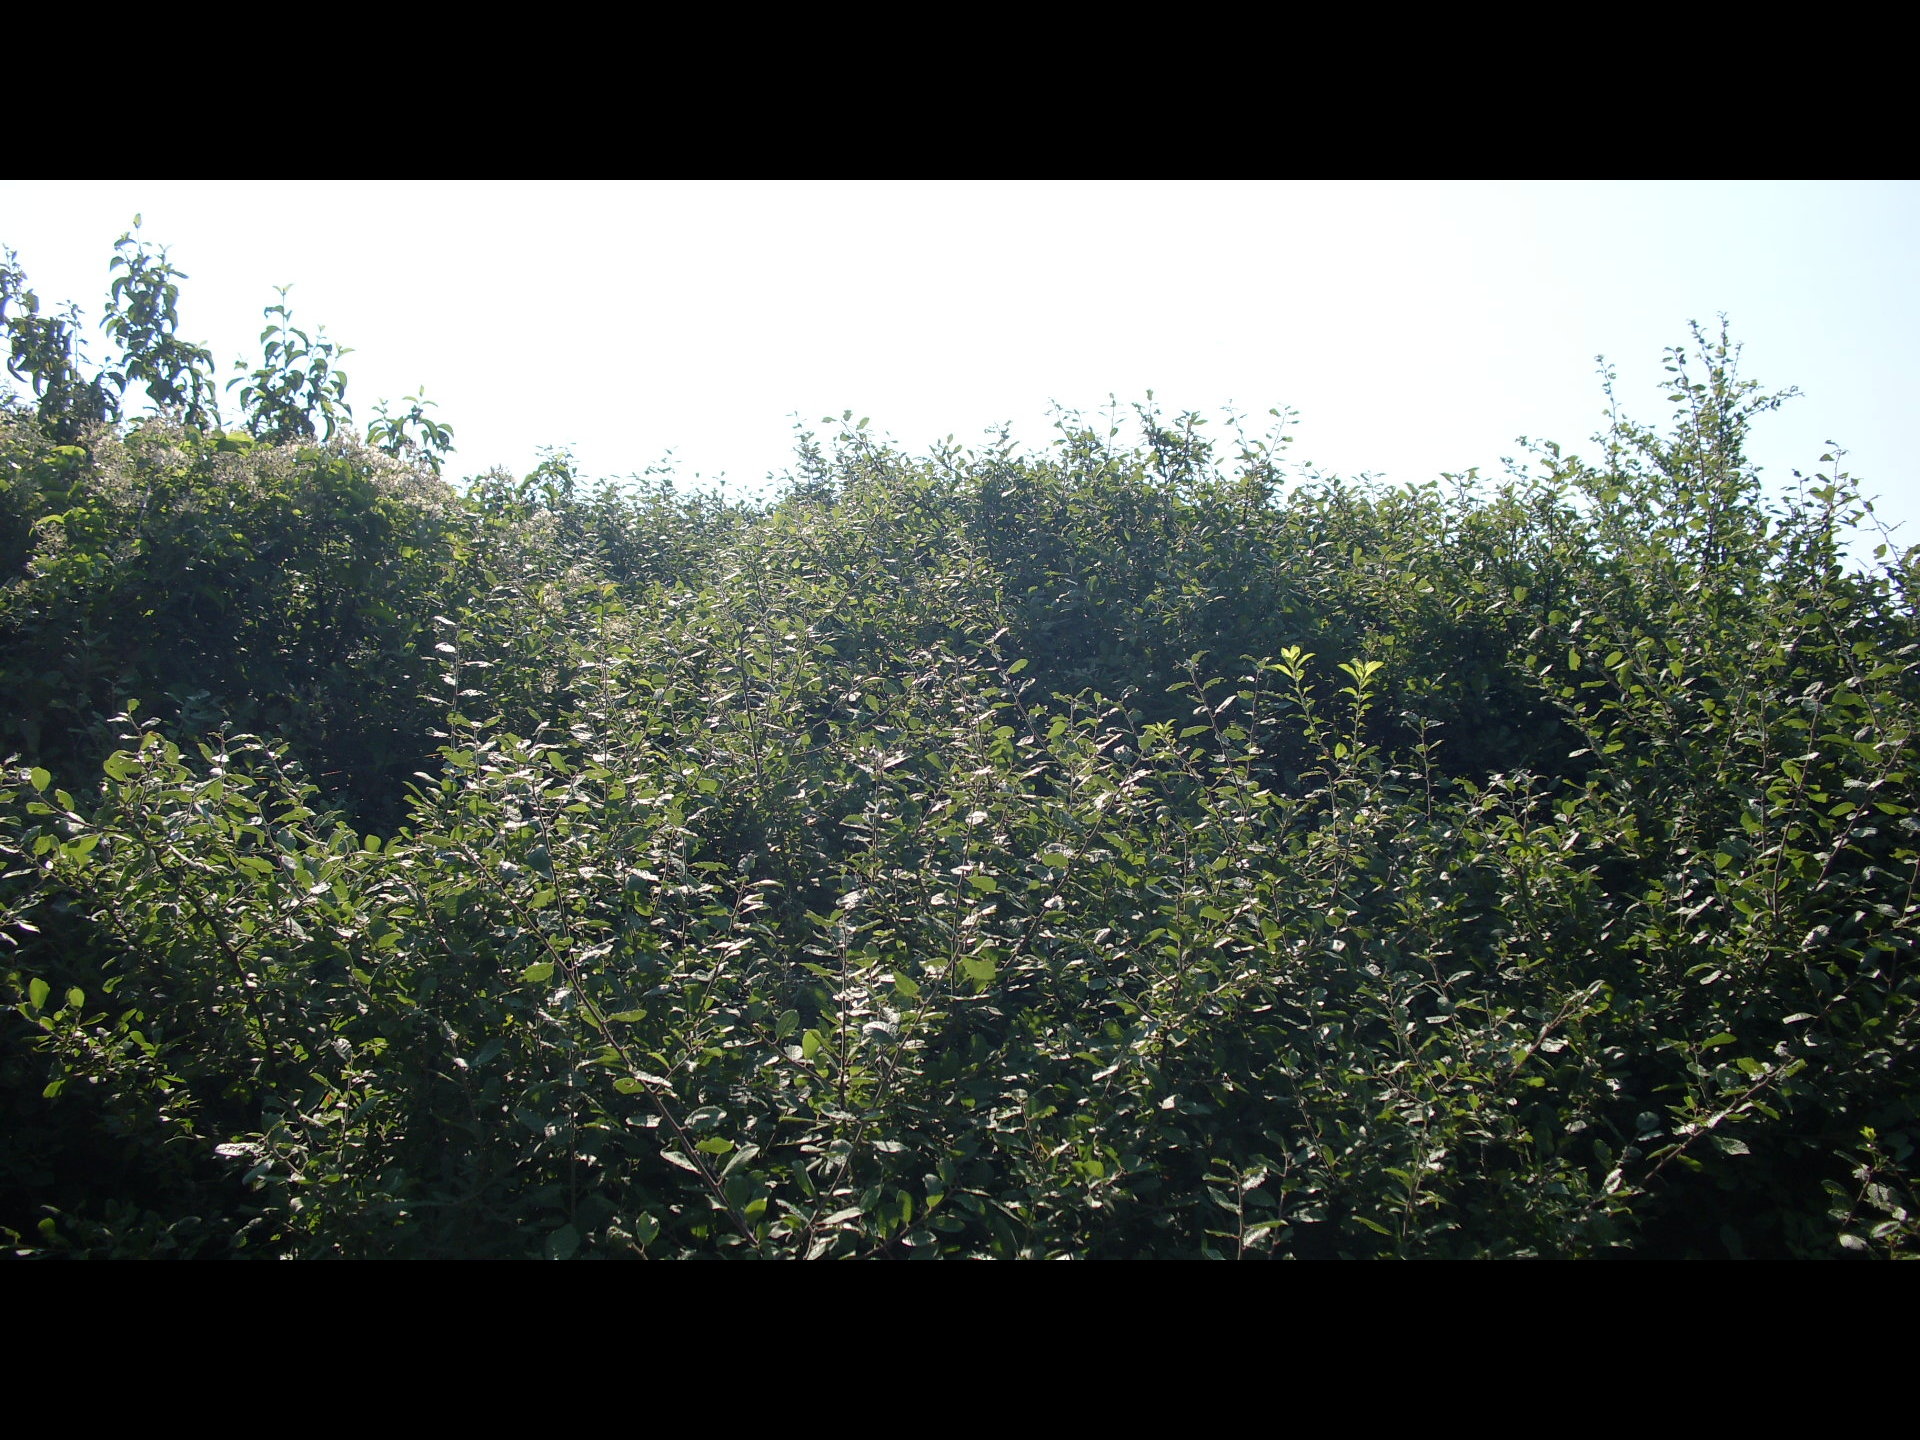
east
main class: Shrubland
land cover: Shrubland without tree cover
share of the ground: > 75 %
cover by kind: shrubs 85 %, herbaceous plants 15 %
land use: Semi-natural and natural areas not in use
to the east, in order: Shrubland without tree cover; Abandoned hedges; Ditches and canals; Abandoned hedges; Tracks; Abandoned hedges; Maize; Tracks; Shrubland with sparse tree cover
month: July
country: BG
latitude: 43.7875
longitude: 22.9754
